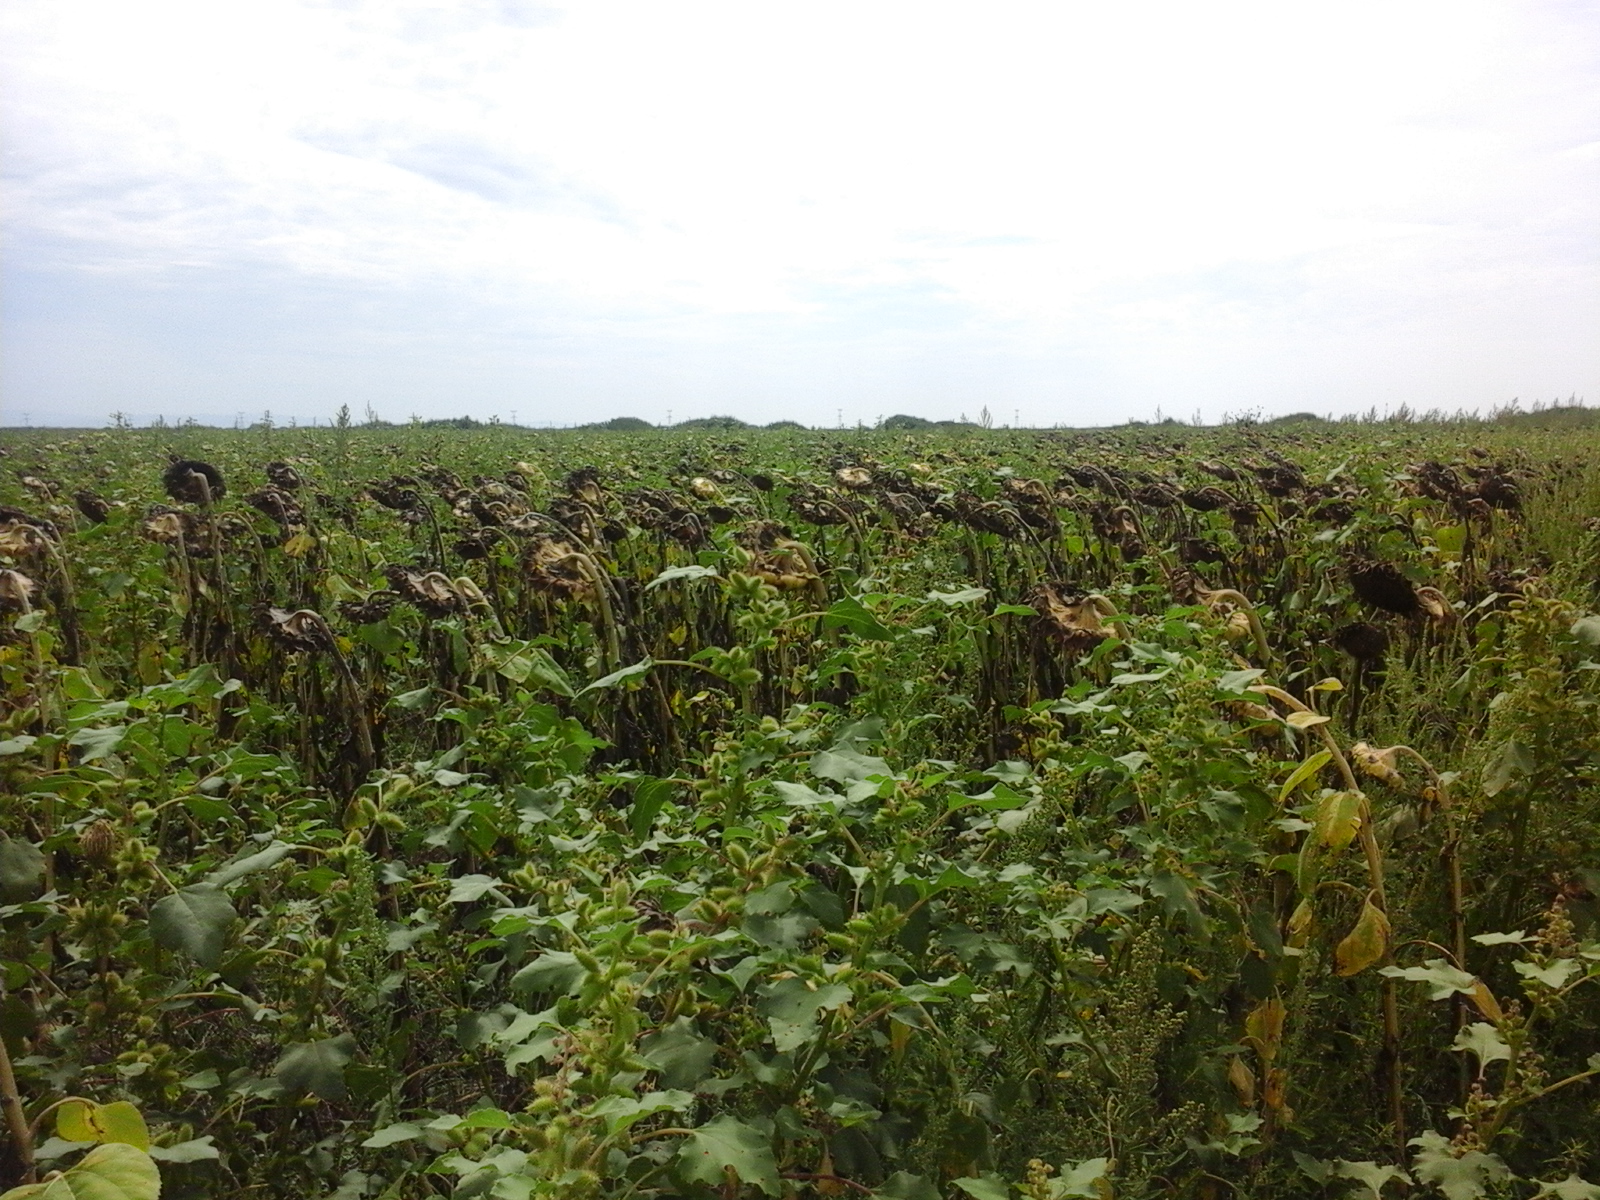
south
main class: Cropland
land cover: Maize
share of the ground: > 75 %
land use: Agriculture (excluding fallow land and kitchen gardens)
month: August
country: RO
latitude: 46.5018
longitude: 21.4125
